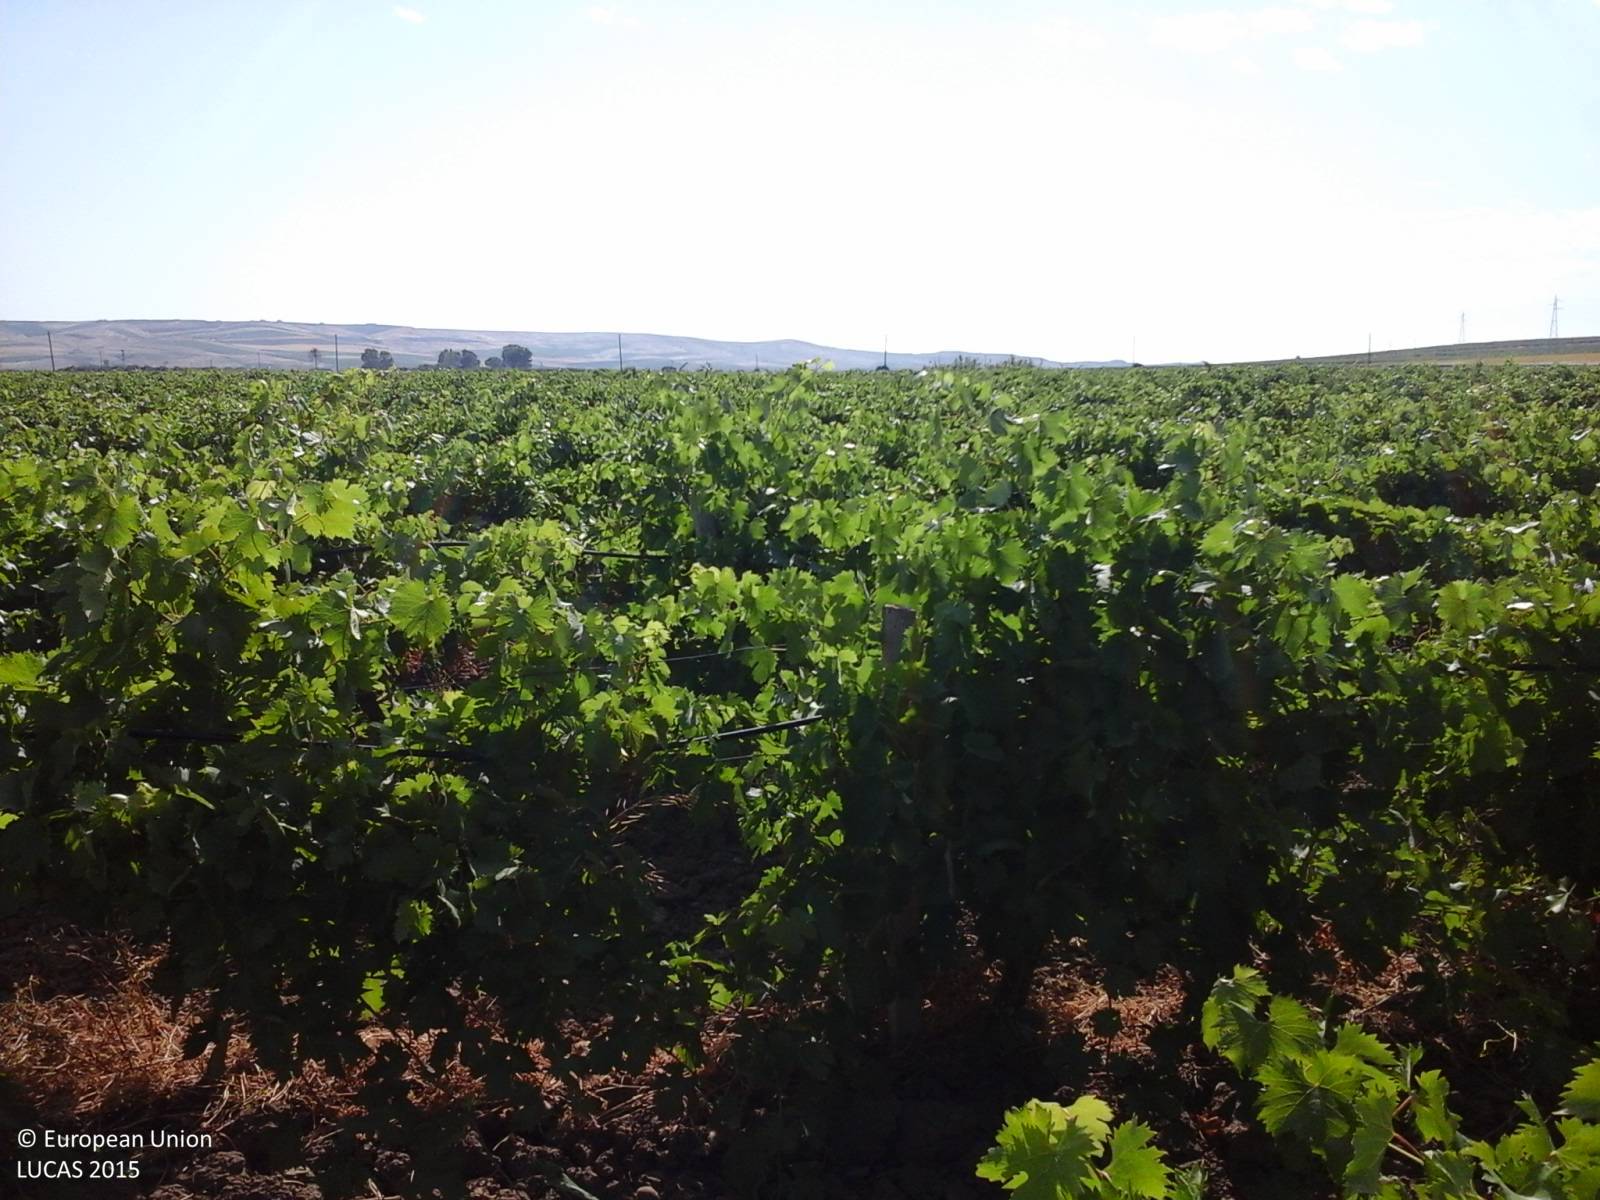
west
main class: Cropland
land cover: Vineyards
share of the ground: 50 - 75 %
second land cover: Other bare soil
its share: > 75 %
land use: Agriculture (excluding fallow land and kitchen gardens)
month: June
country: IT
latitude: 37.8759
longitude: 12.5844
